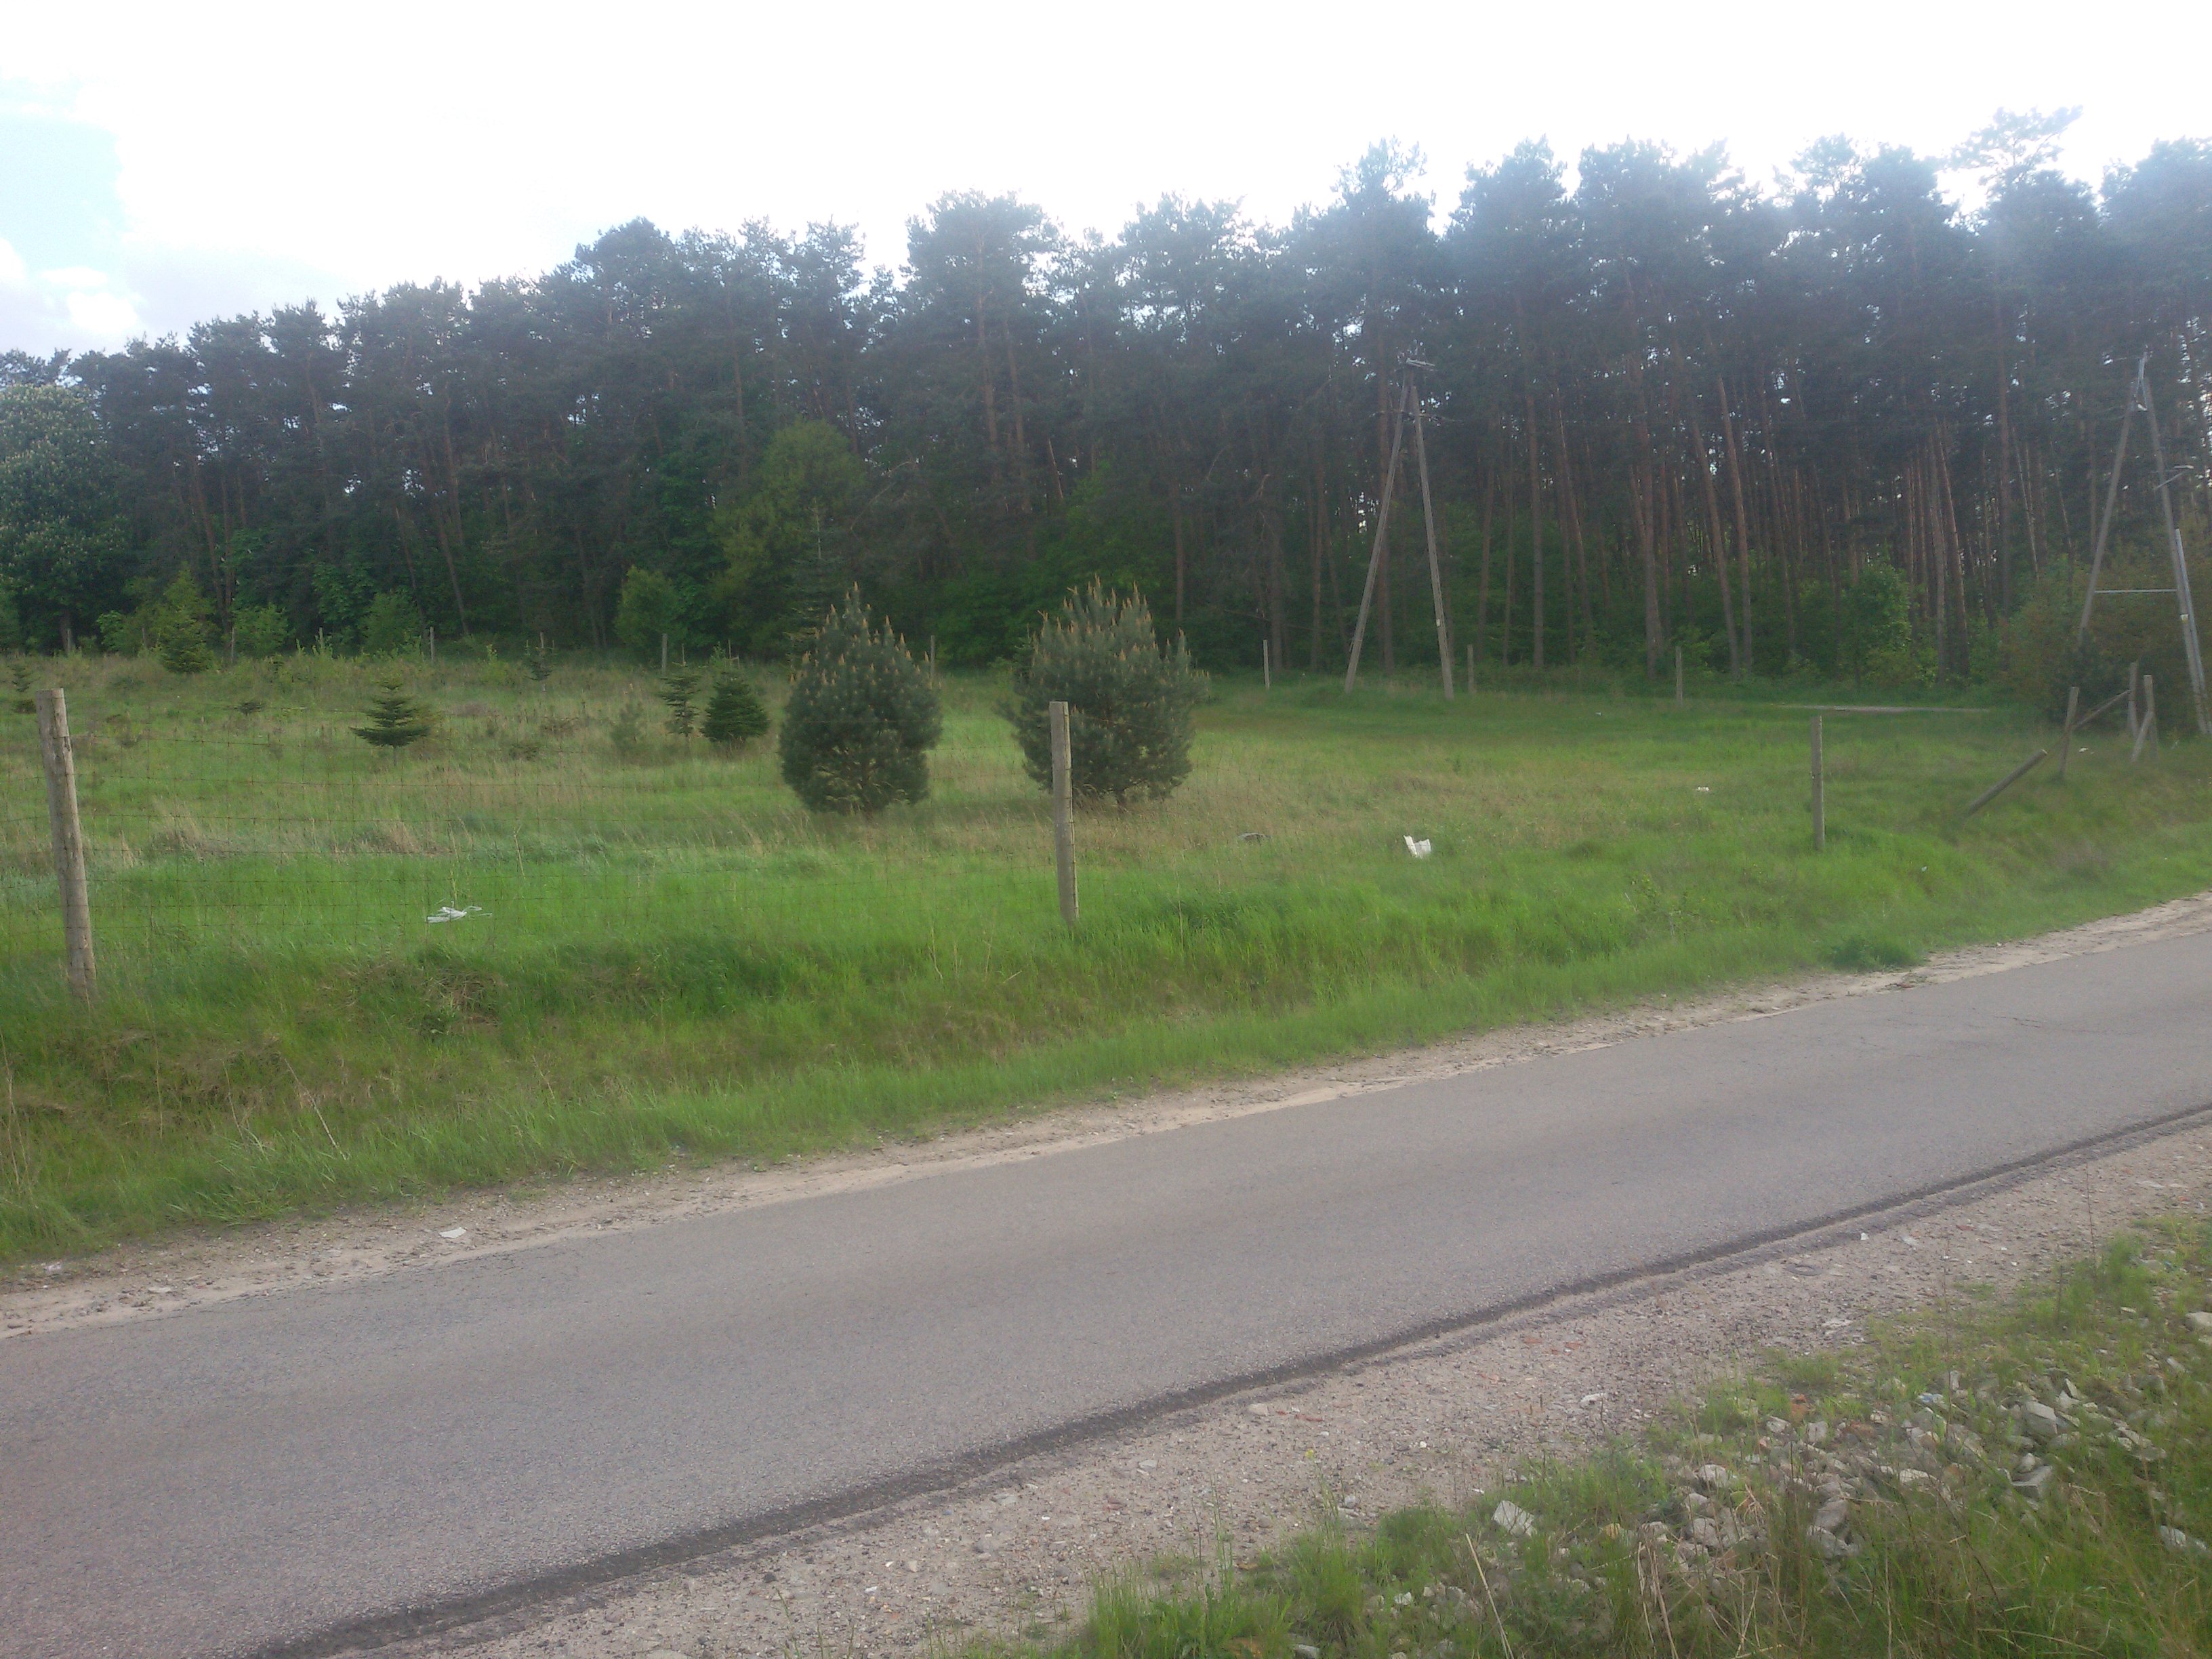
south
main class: Grassland
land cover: Grassland with sparse tree/shrub cover
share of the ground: > 75 %
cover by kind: herbaceous plants 95 %, coniferous forest trees 5 %
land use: Semi-natural and natural areas not in use
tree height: < 5 m
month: May
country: PL
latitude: 53.5160
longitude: 14.5103
